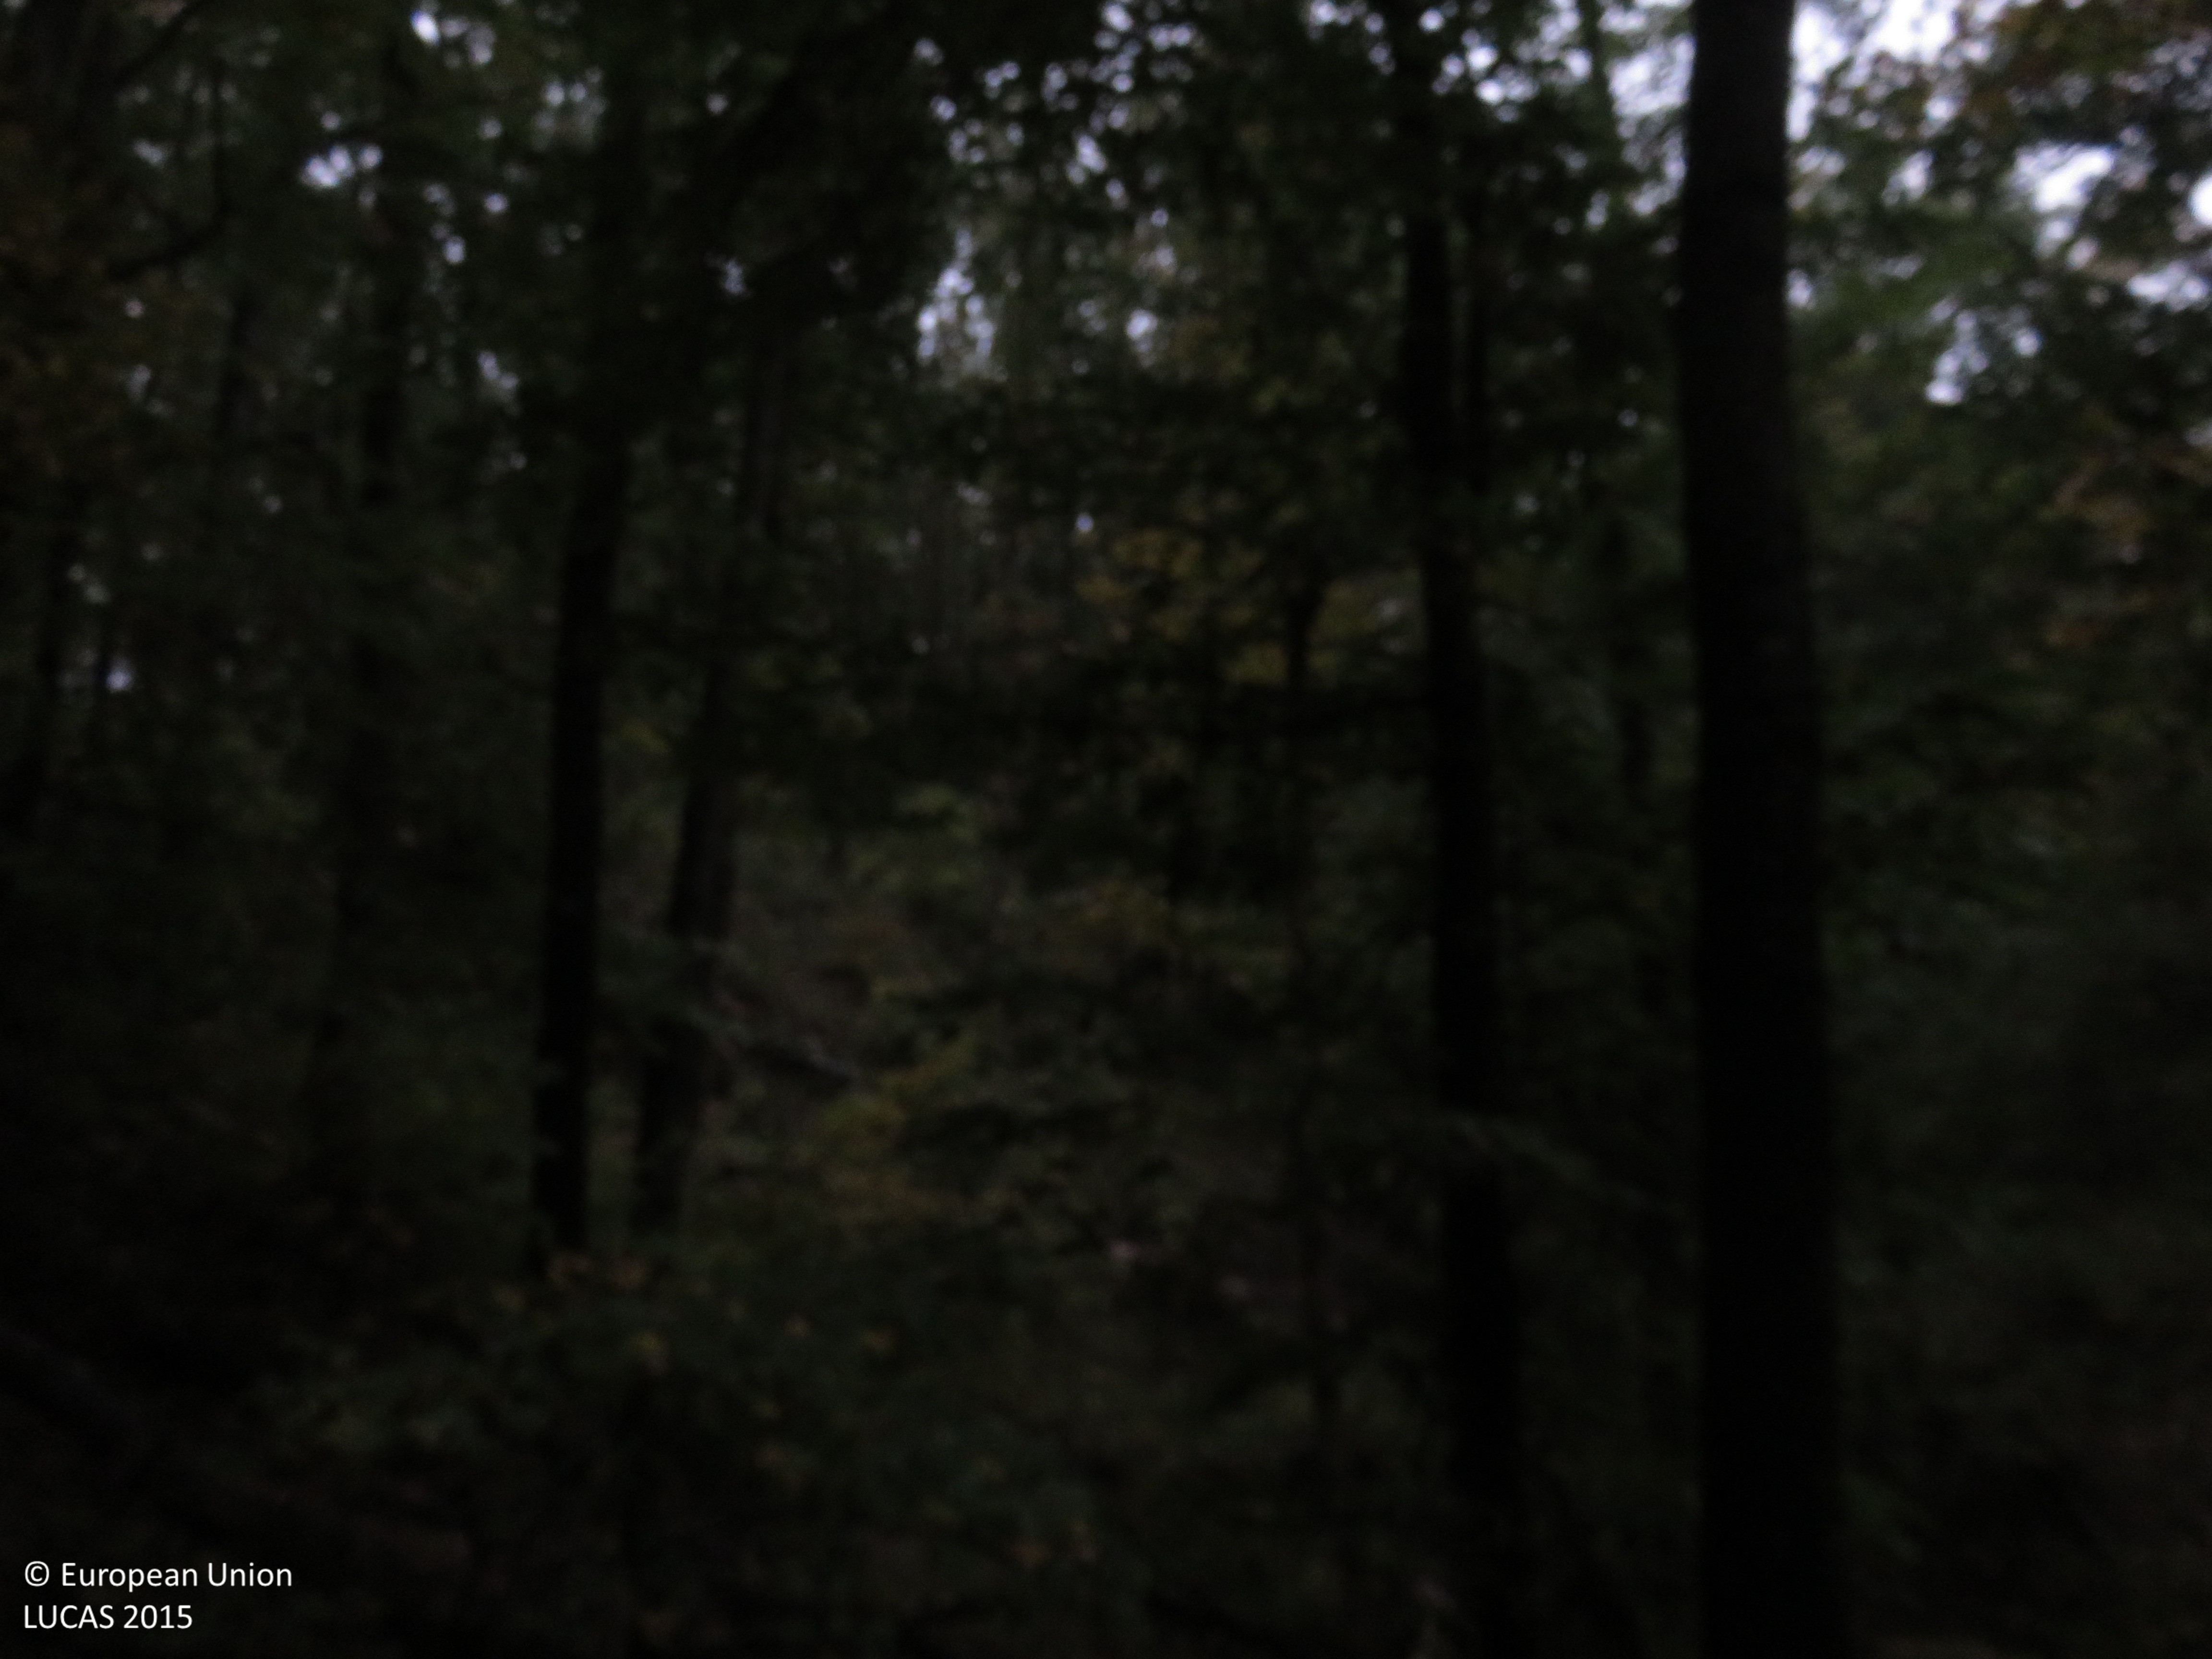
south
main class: Woodland
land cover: Broadleaved woodland
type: mesophytic deciduous forest
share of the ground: > 75 %
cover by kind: broadleaved forest trees 95 %, unconsolidated bare surface 5 %
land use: Forestry
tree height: < 5 m
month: October
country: BG
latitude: 43.0493
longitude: 25.2576
